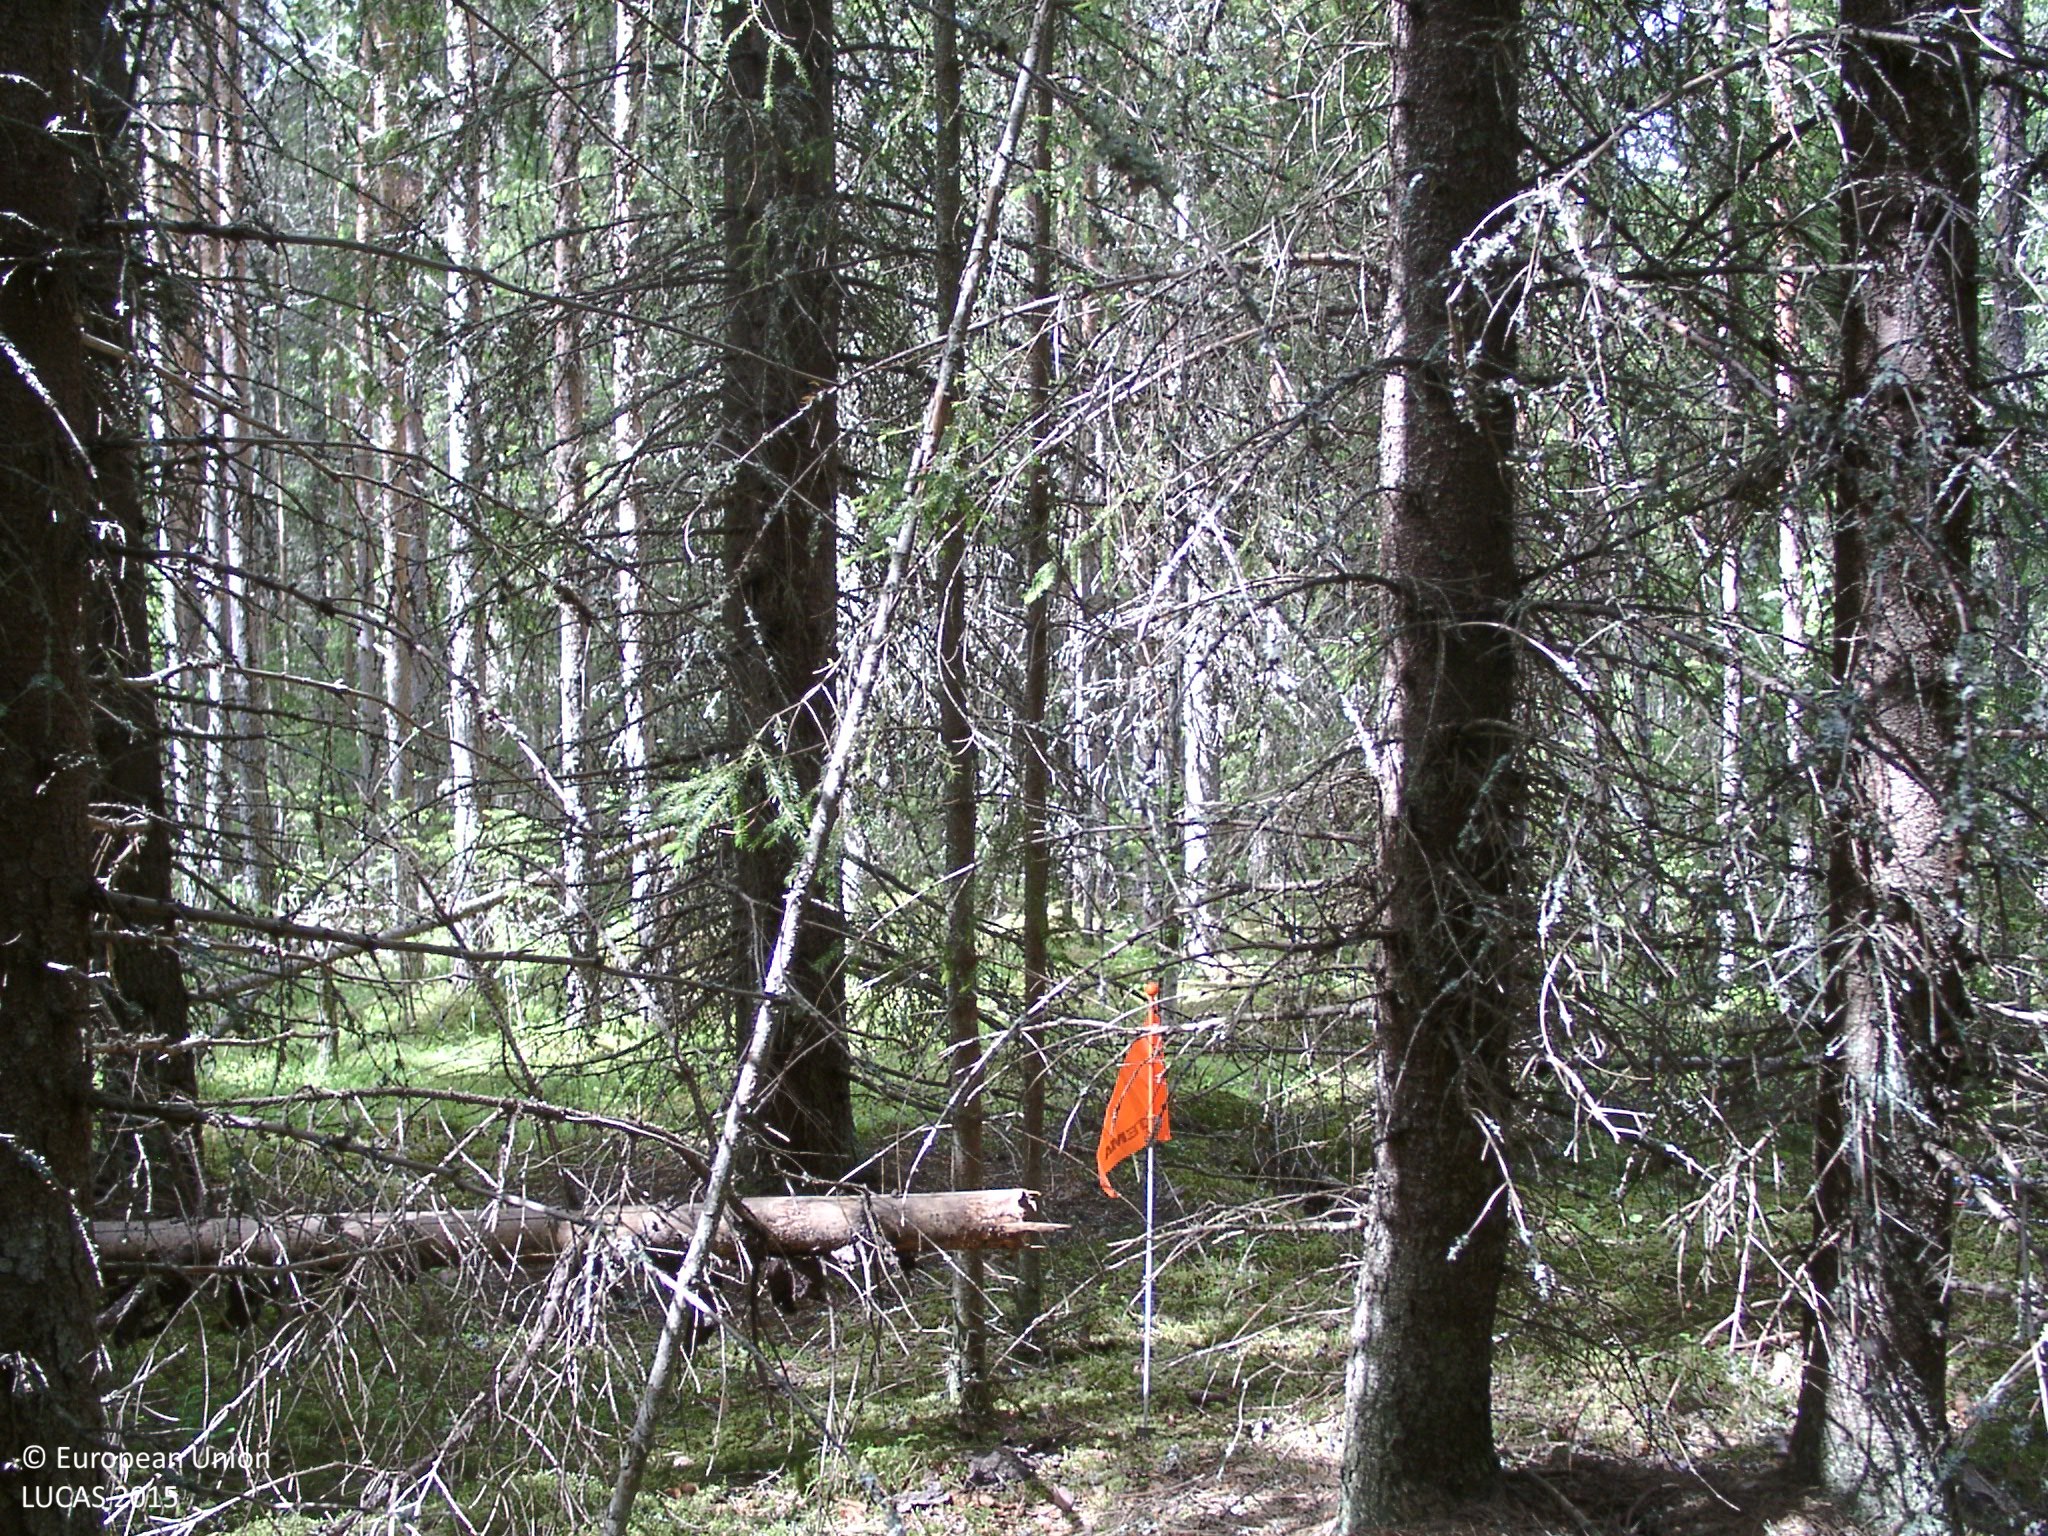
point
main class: Woodland
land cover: Spruce dominated coniferous woodland
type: boreal forest
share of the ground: > 75 %
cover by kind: coniferous forest trees 75 %, lichens and mosses 20 %, shrubs 5 %
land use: Semi-natural and natural areas not in use
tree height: > 5 m
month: June
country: FI
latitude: 61.8447
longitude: 24.5536
